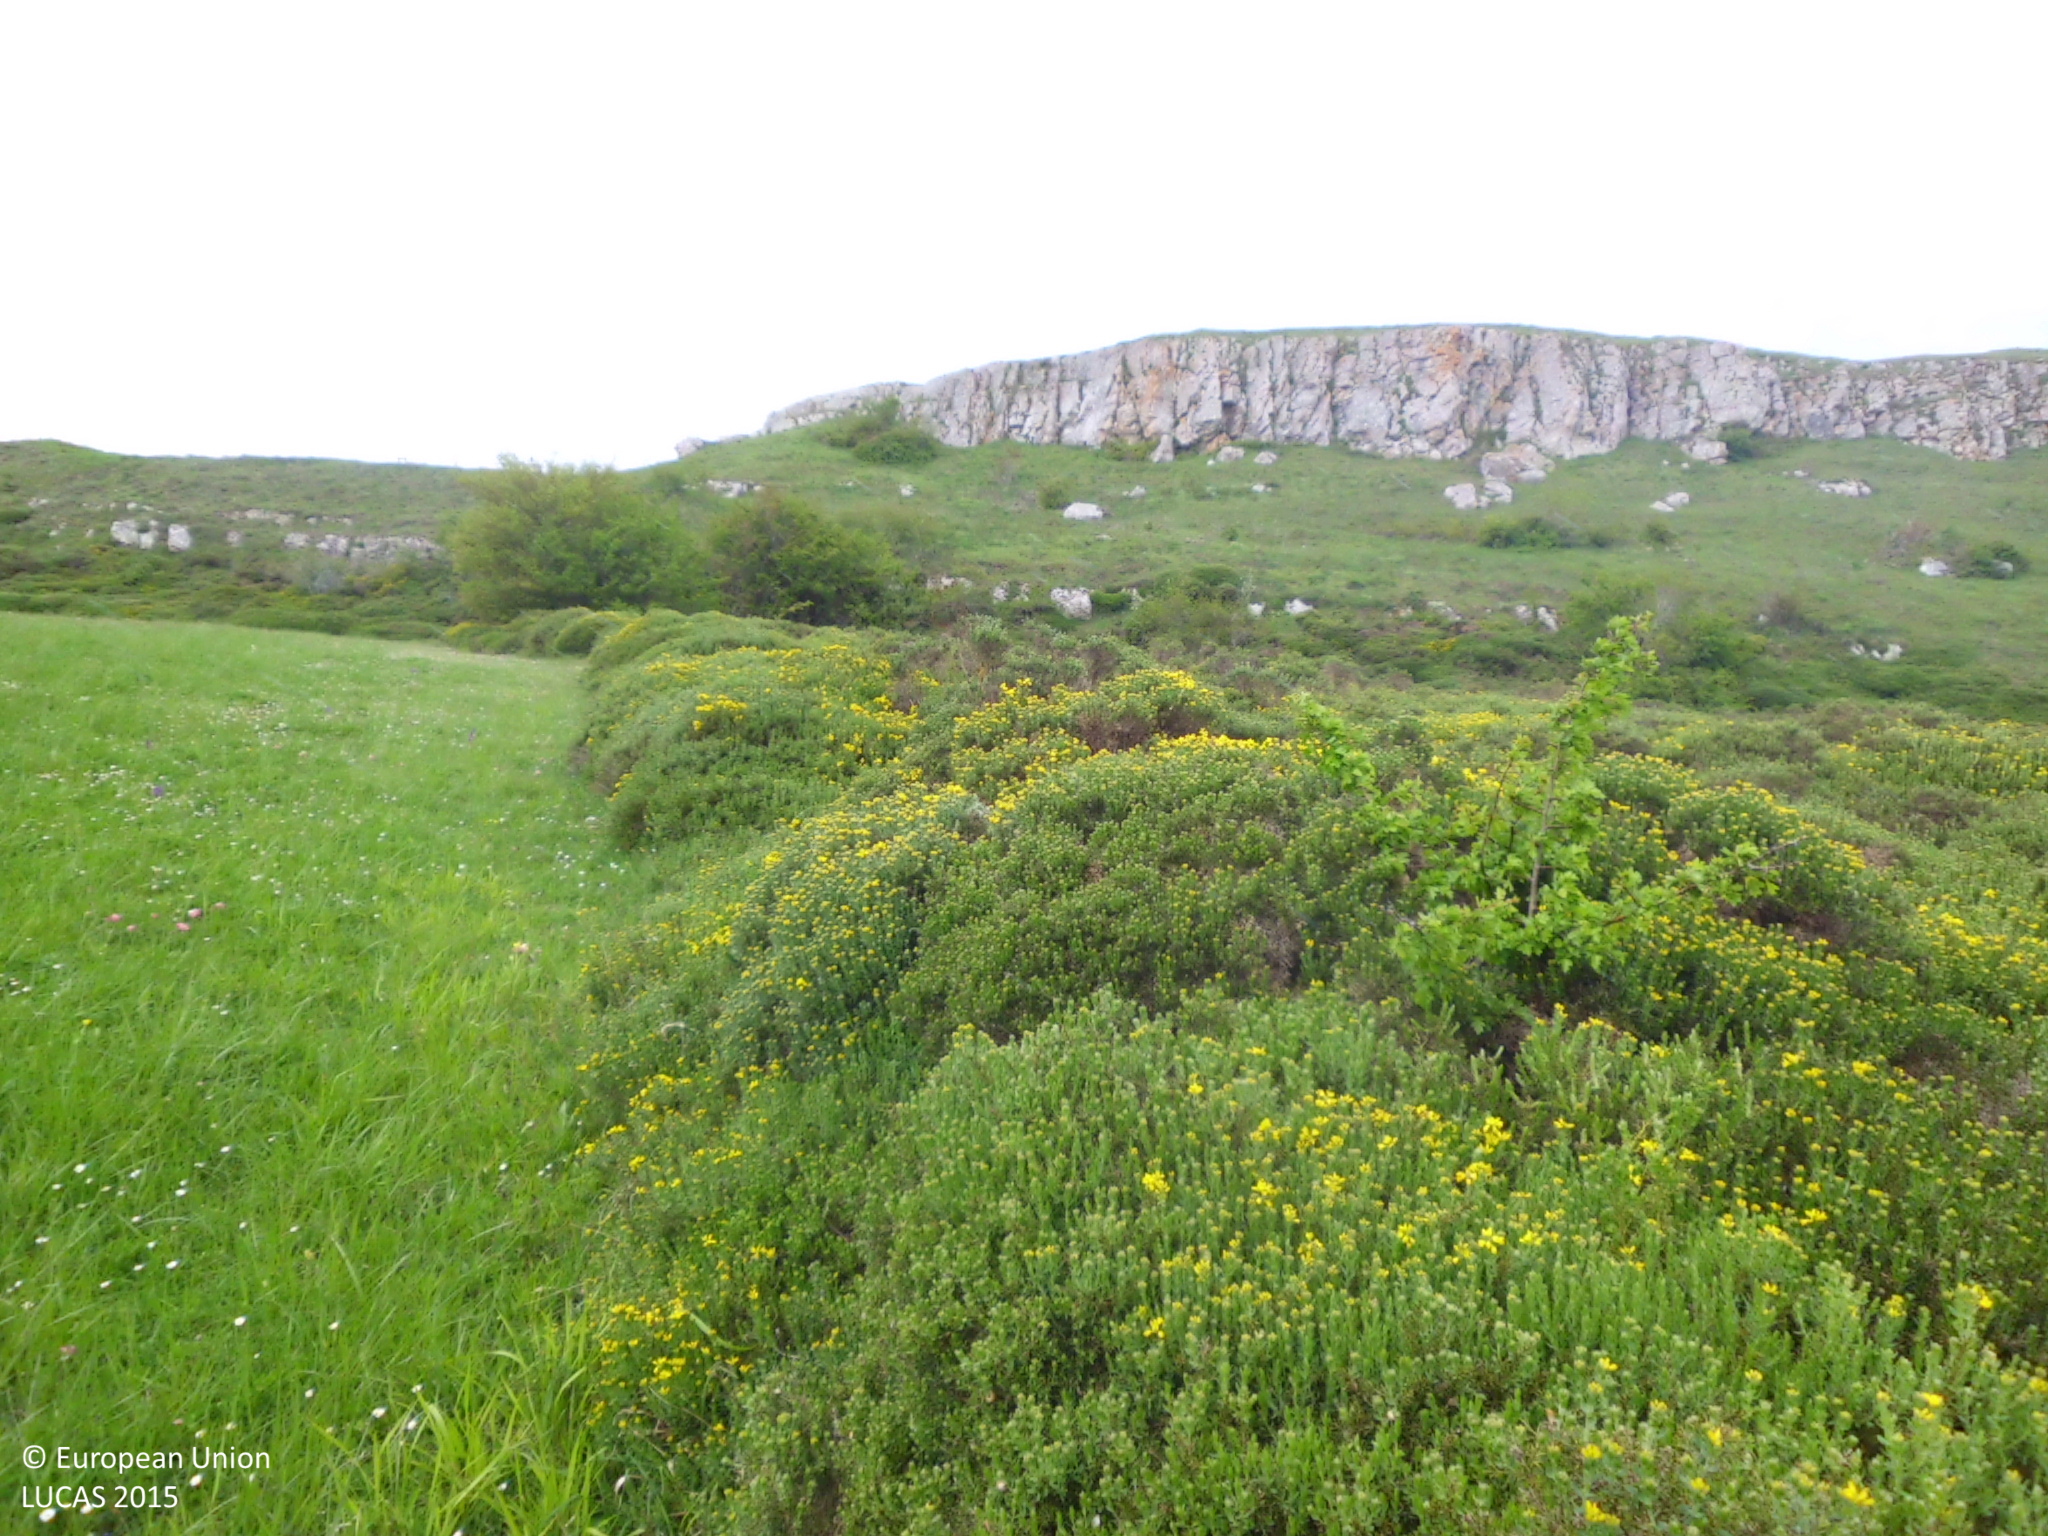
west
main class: Shrubland
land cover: Shrubland without tree cover
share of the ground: > 75 %
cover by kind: shrubs 80 %, herbaceous plants 20 %
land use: Semi-natural and natural areas not in use
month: May
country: ES
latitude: 42.9050
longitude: -3.8477
